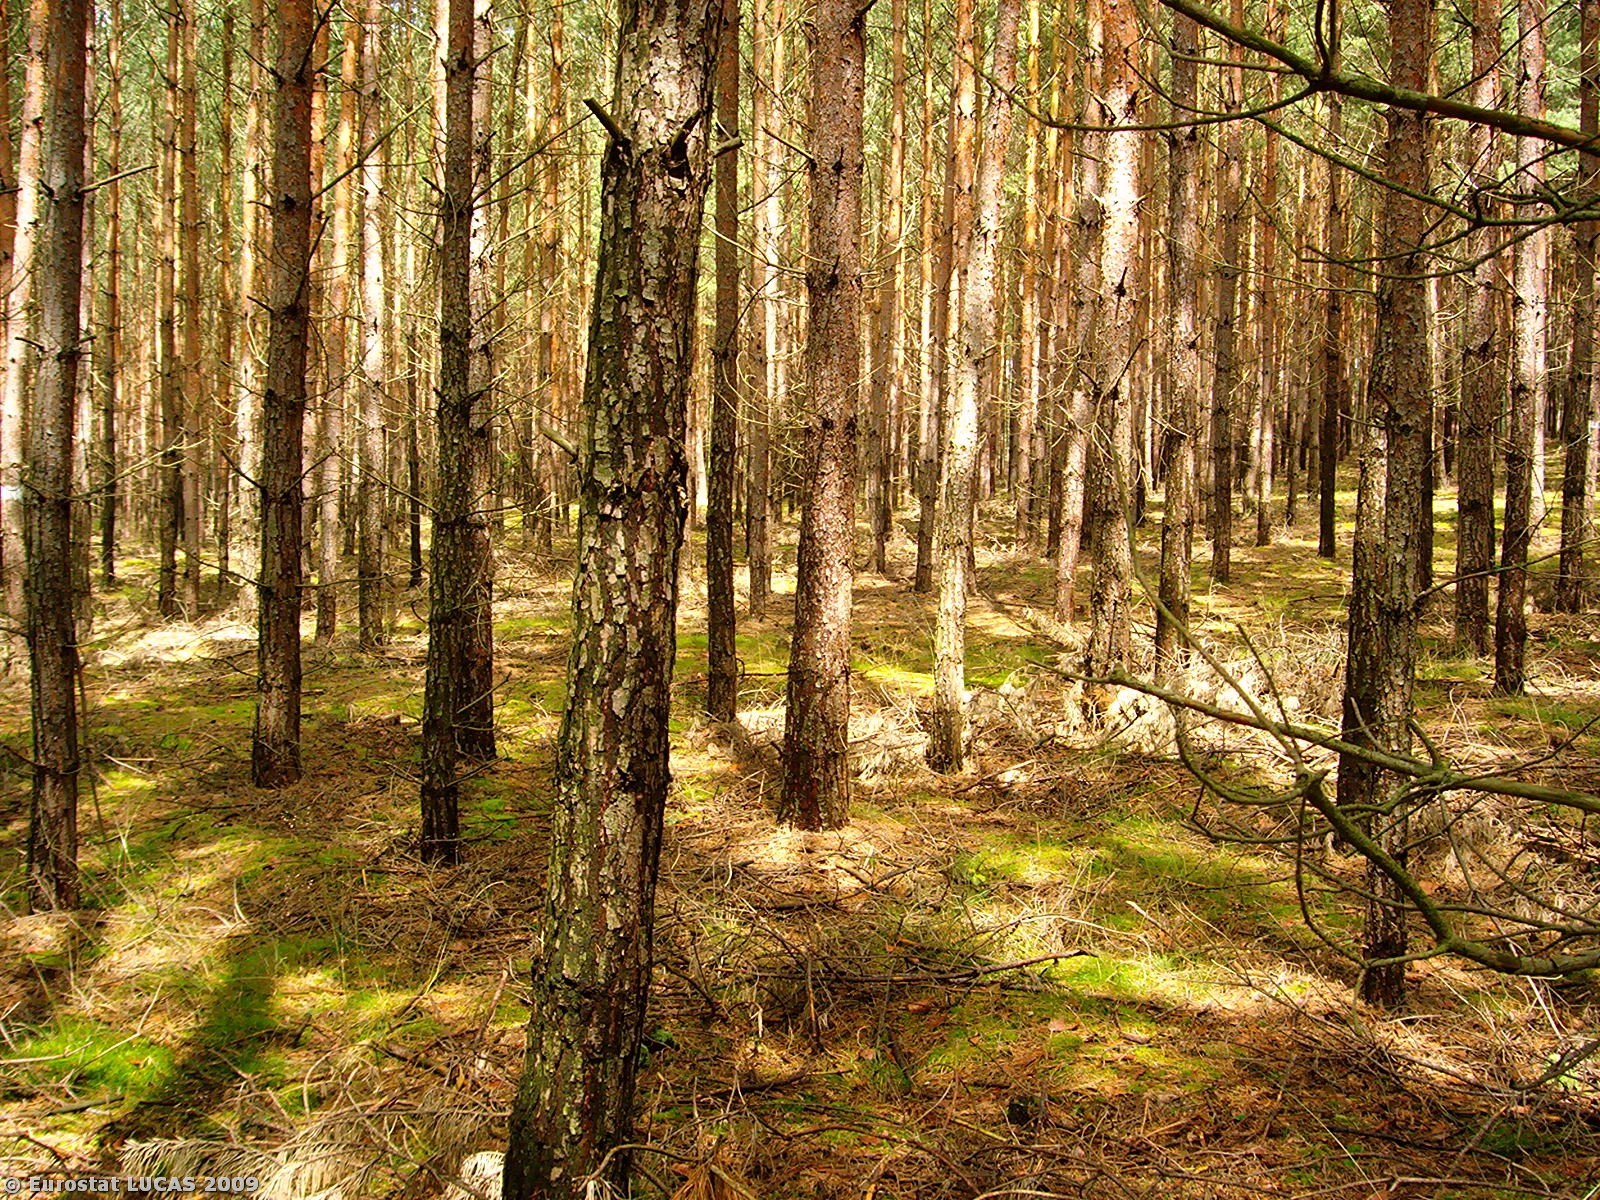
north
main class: Woodland
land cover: Coniferous woodland
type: hemiboreal forest and nemoral coniferous forest and mixed broadleaved-coniferous forest
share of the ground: > 75 %
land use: Forestry
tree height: > 5 m
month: July
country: PL
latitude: 52.2927
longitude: 15.3552
